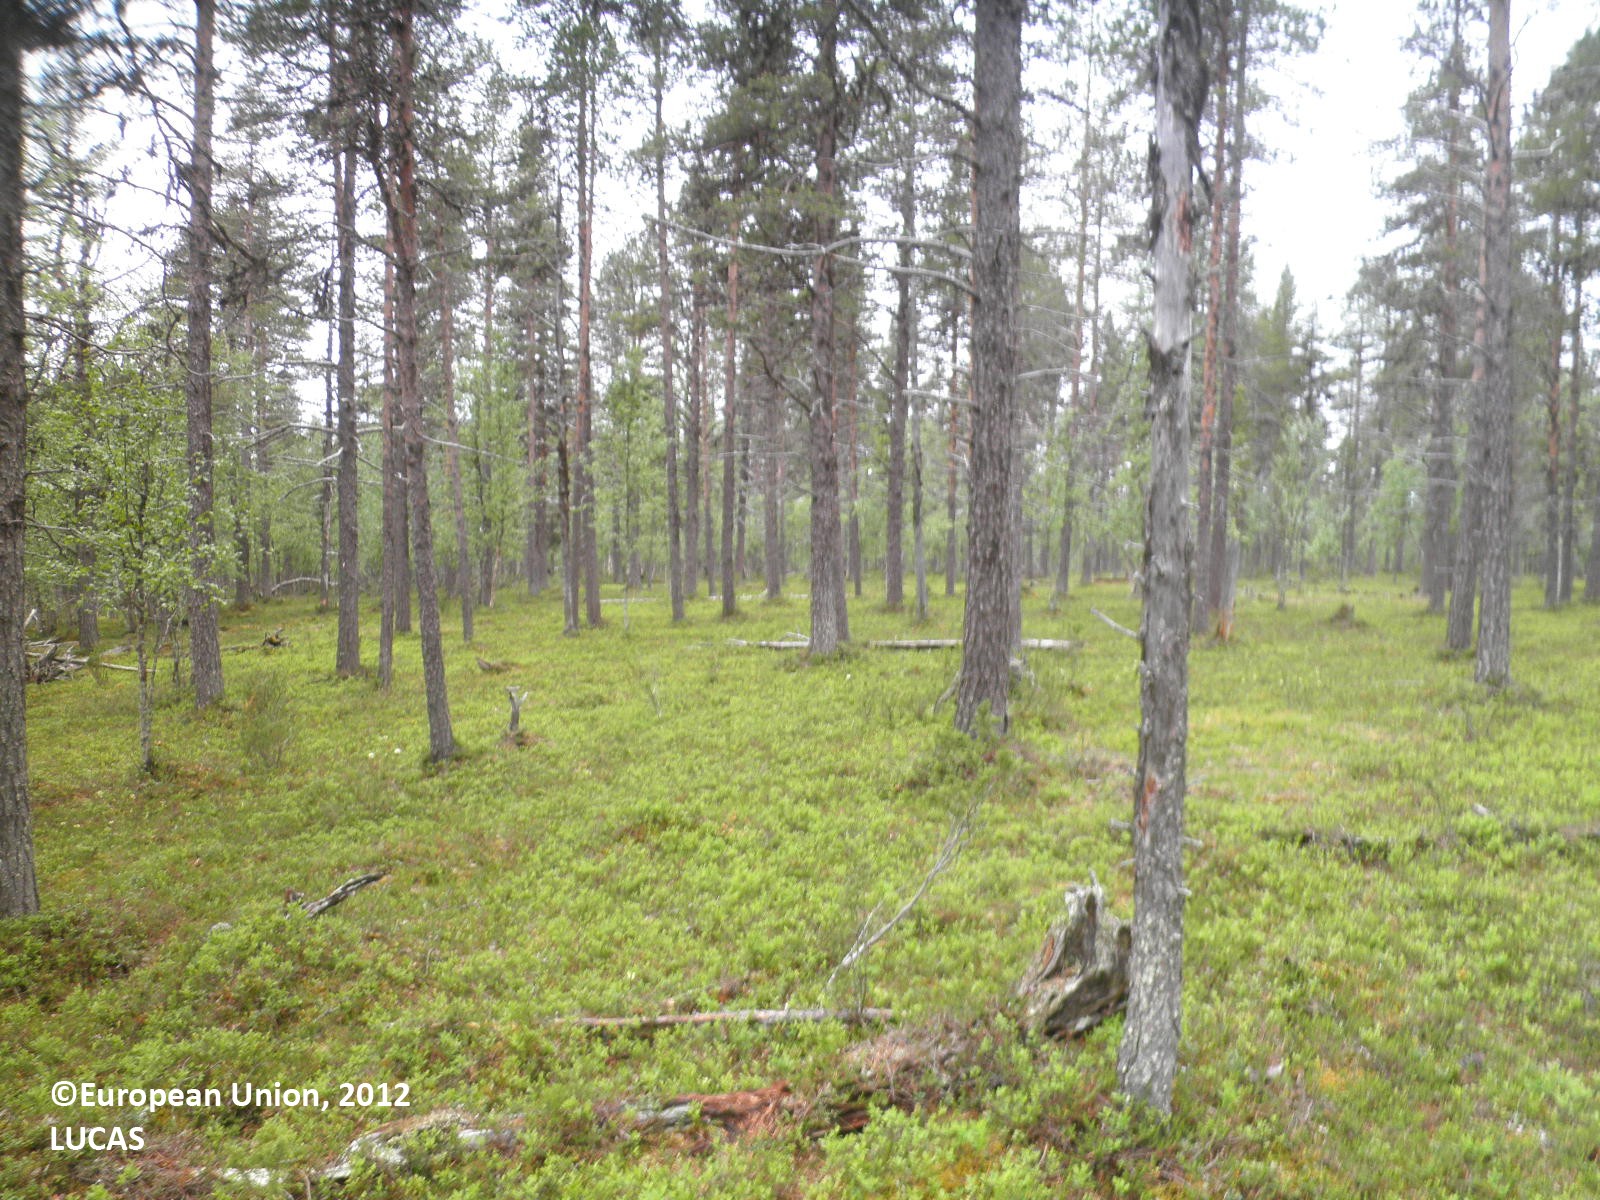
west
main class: Woodland
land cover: Pine dominated coniferous woodland
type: boreal forest
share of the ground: 25 - 50 %
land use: Forestry
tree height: > 5 m
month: July
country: FI
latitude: 68.4322
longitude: 25.9115
